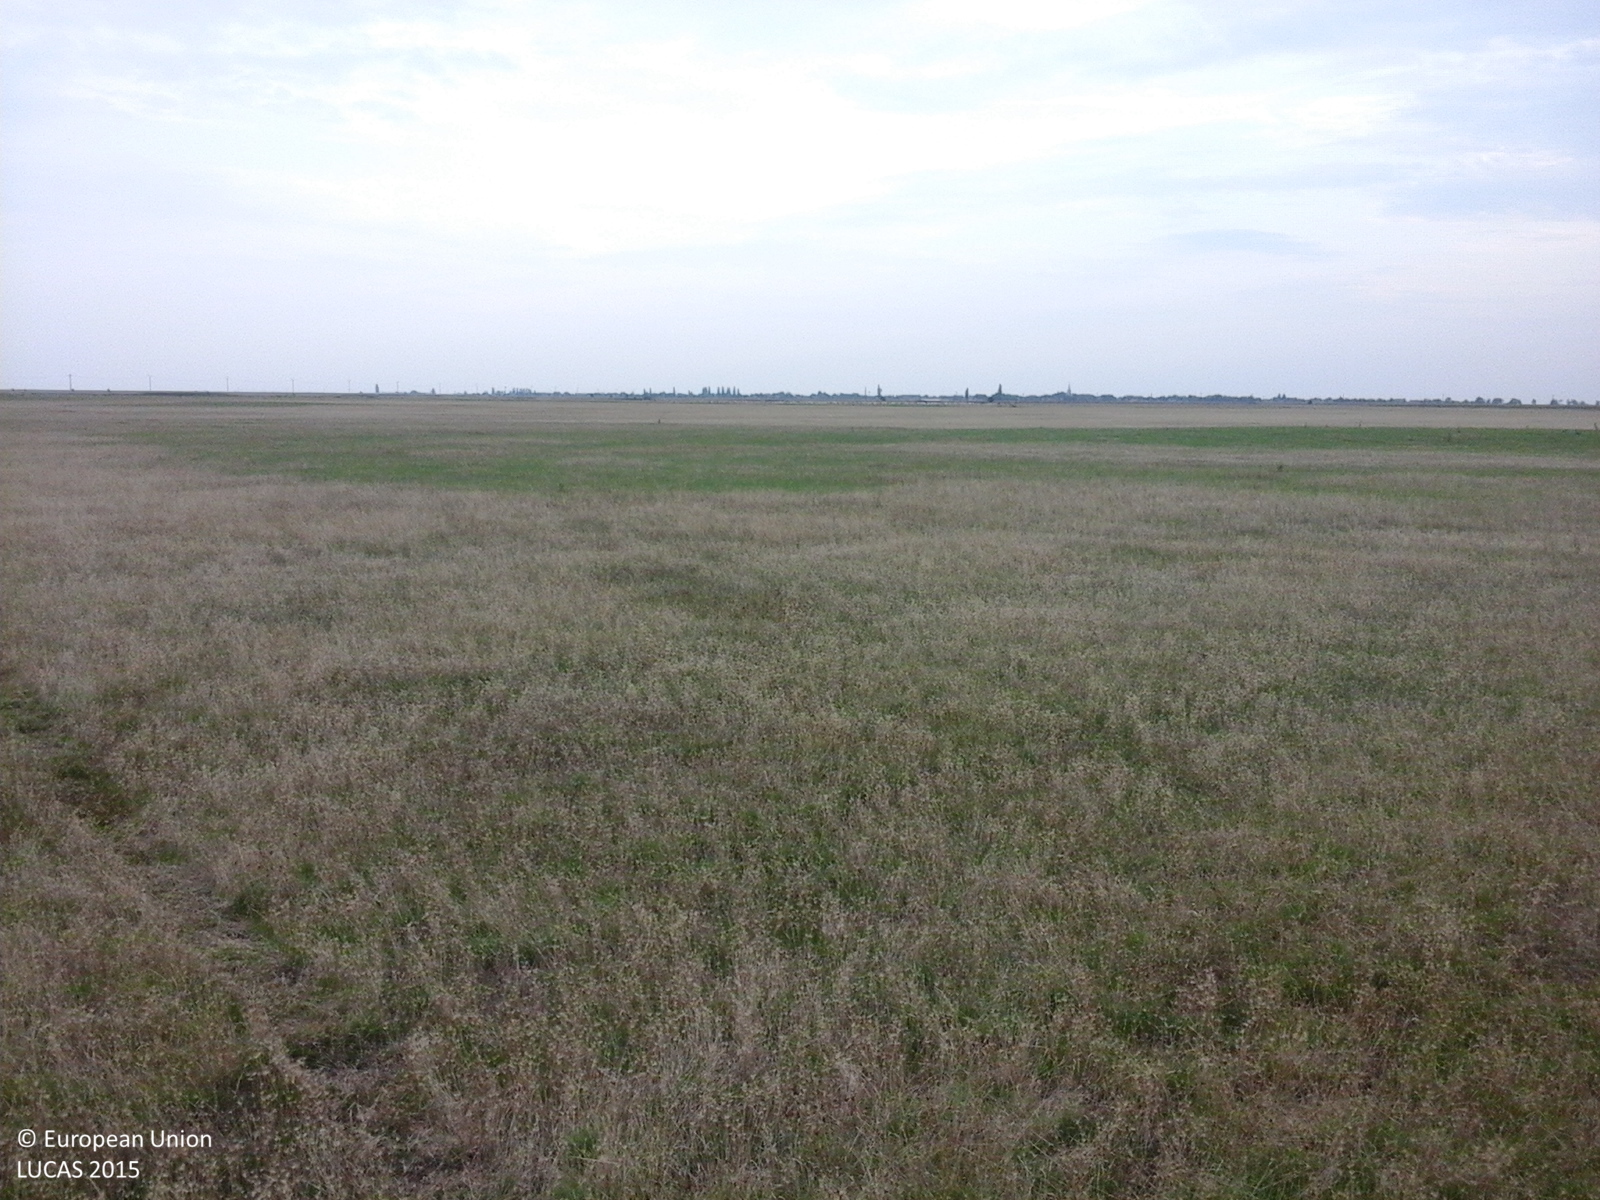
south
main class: Grassland
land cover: Grassland without tree/shrub cover
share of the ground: > 75 %
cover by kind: herbaceous plants 100 %
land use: Agriculture (excluding fallow land and kitchen gardens)
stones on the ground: < 10 %
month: August
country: RO
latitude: 46.3405
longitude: 21.2200
